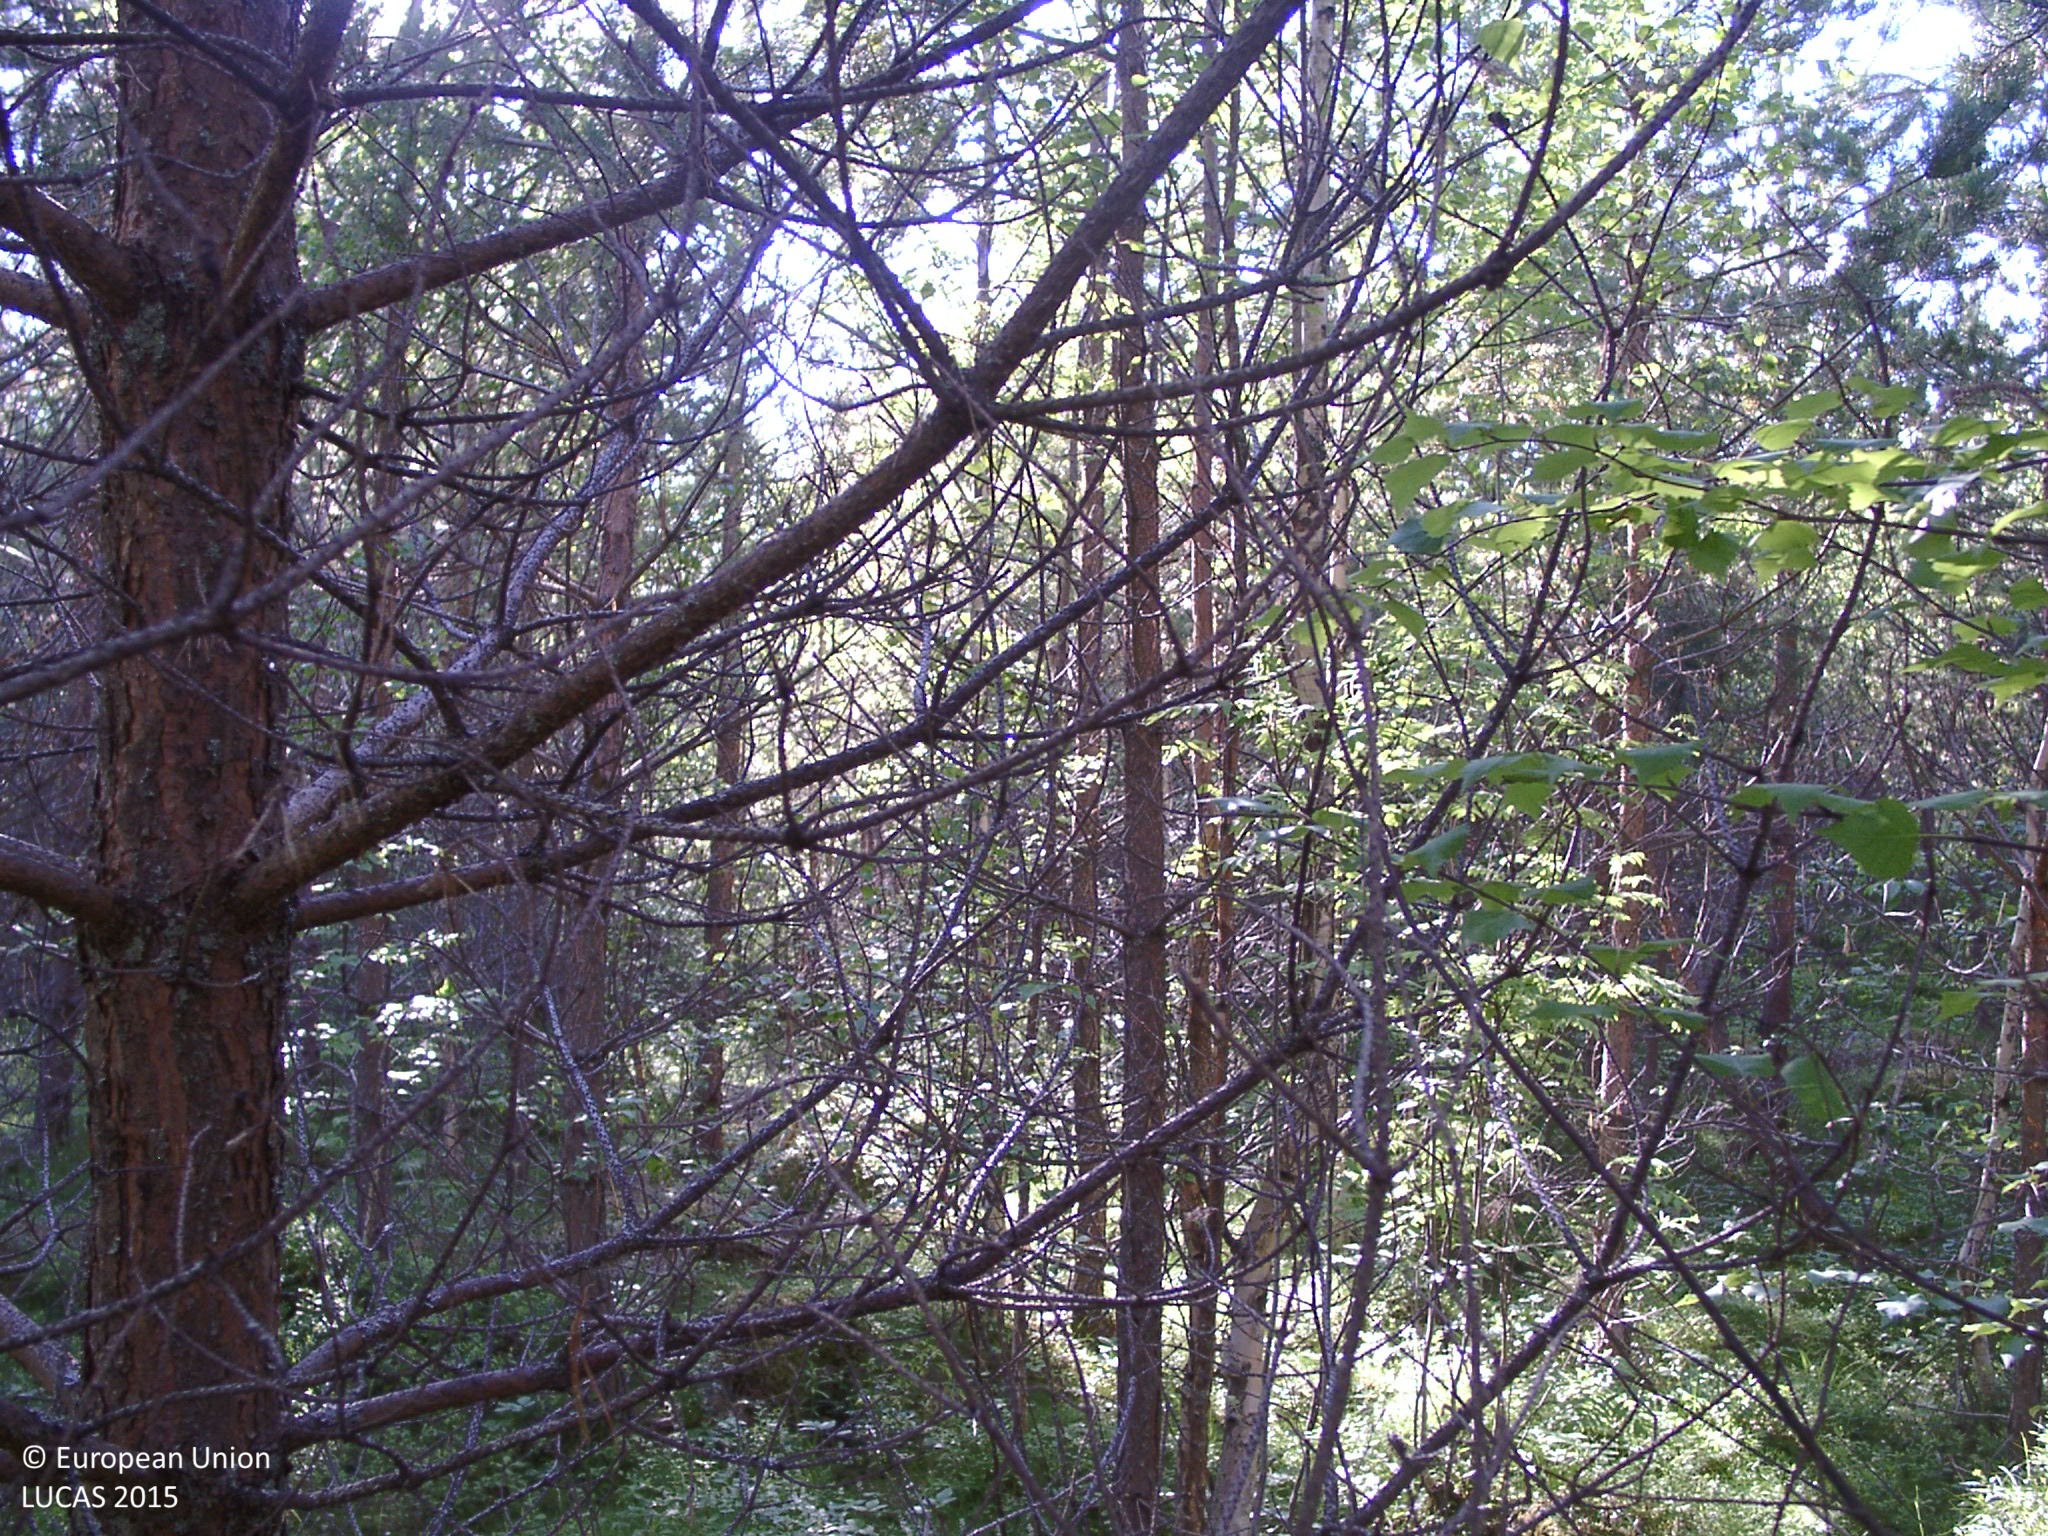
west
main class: Woodland
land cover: Pine dominated coniferous woodland
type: boreal forest
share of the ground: 50 - 75 %
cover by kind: coniferous forest trees 55 %, shrubs 20 %, broadleaved forest trees 15 %, herbaceous plants 10 %
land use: Forestry
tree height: > 5 m
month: June
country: FI
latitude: 62.2021
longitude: 24.8423
